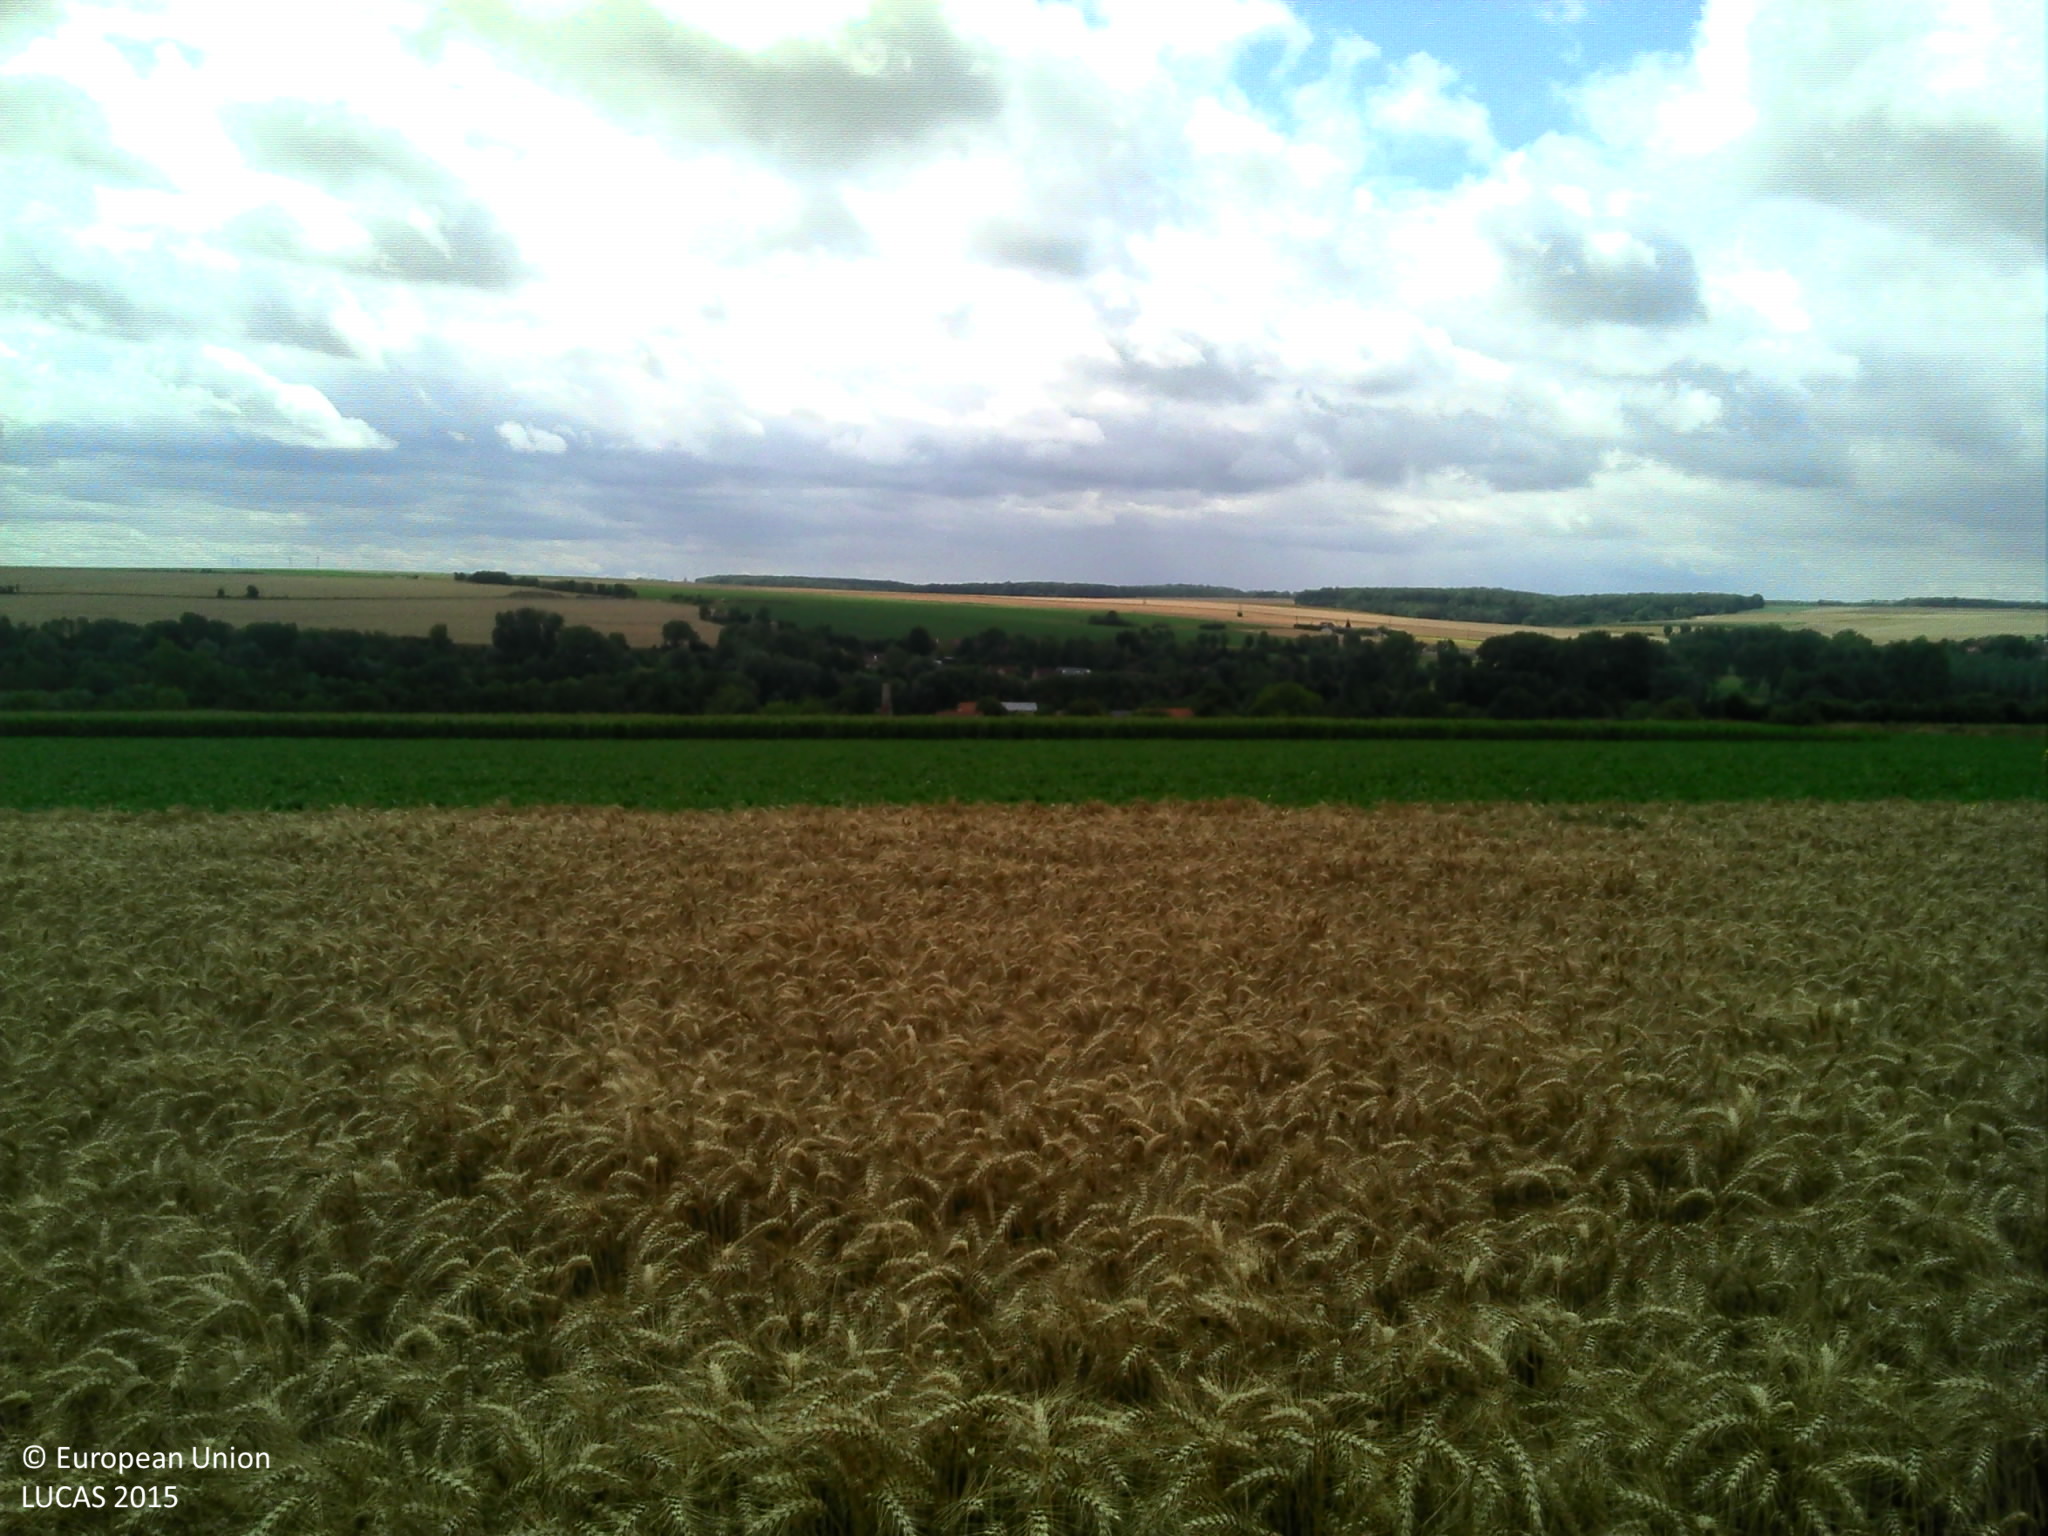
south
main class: Cropland
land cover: Common wheat
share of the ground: > 75 %
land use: Agriculture (excluding fallow land and kitchen gardens)
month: July
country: FR
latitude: 49.8320
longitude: 2.5501
